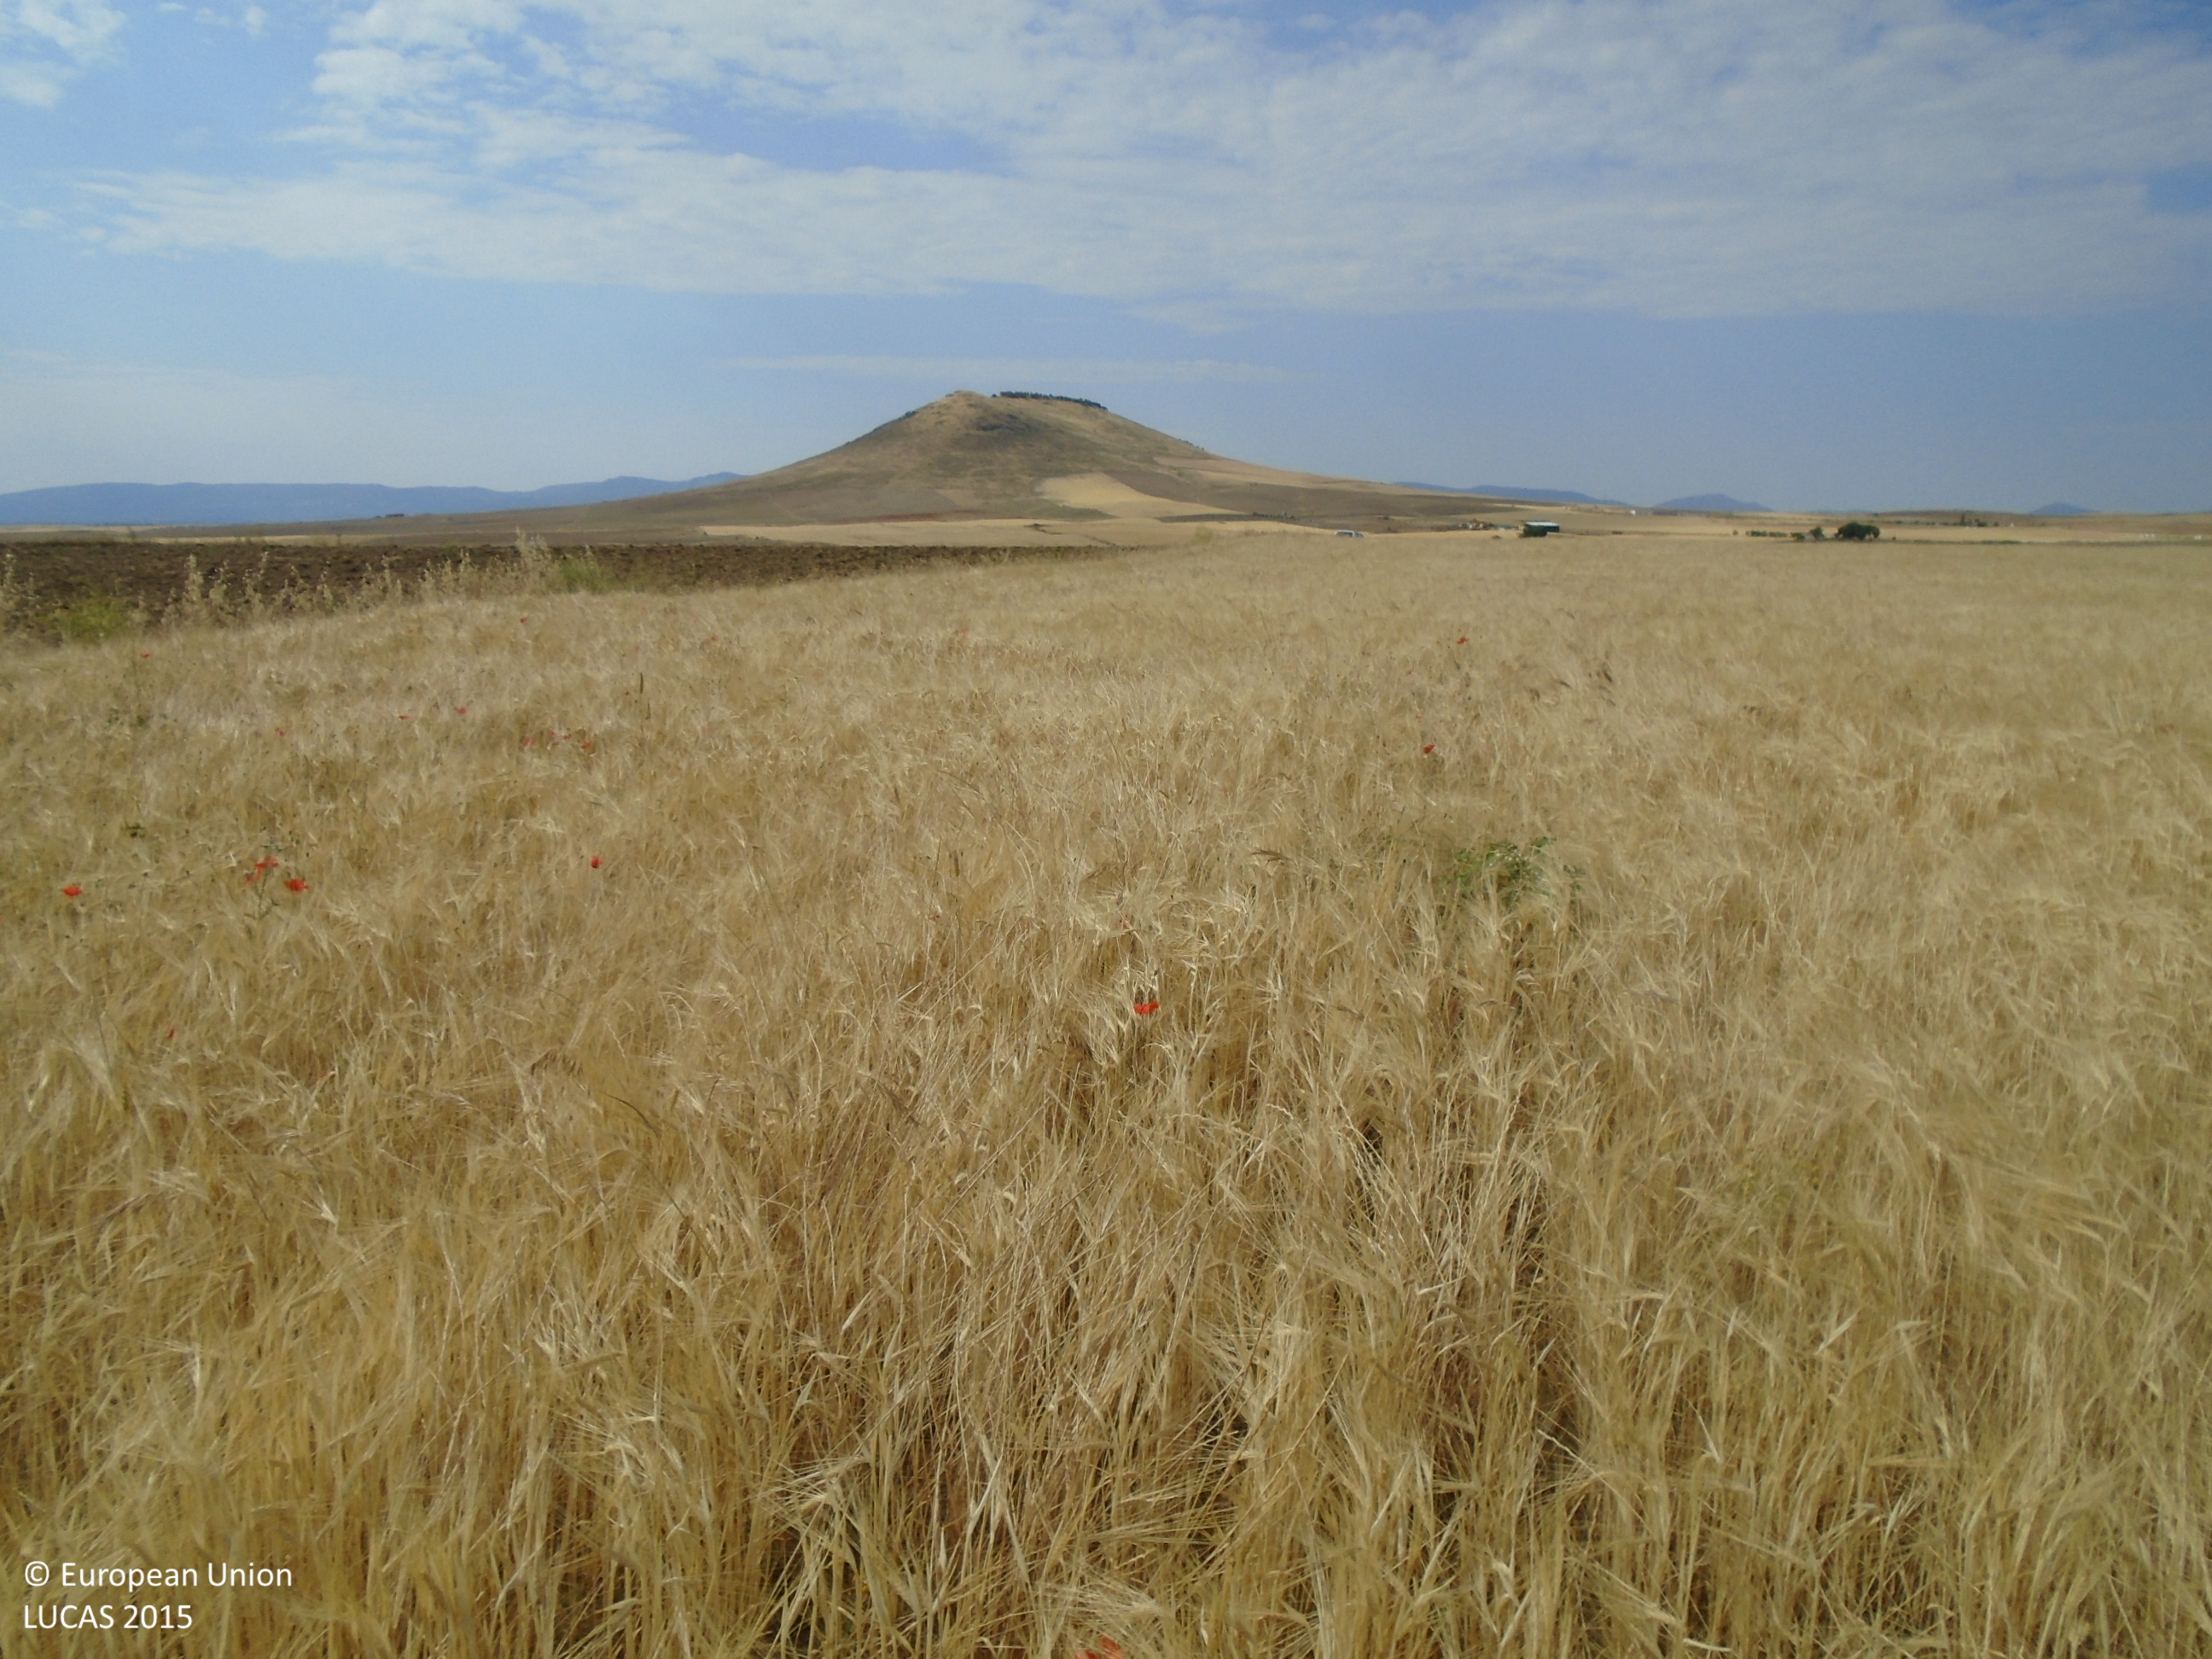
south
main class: Cropland
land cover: Barley
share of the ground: > 75 %
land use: Agriculture (excluding fallow land and kitchen gardens)
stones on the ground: < 10 %
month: June
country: ES
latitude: 39.7292
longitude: -4.1636
